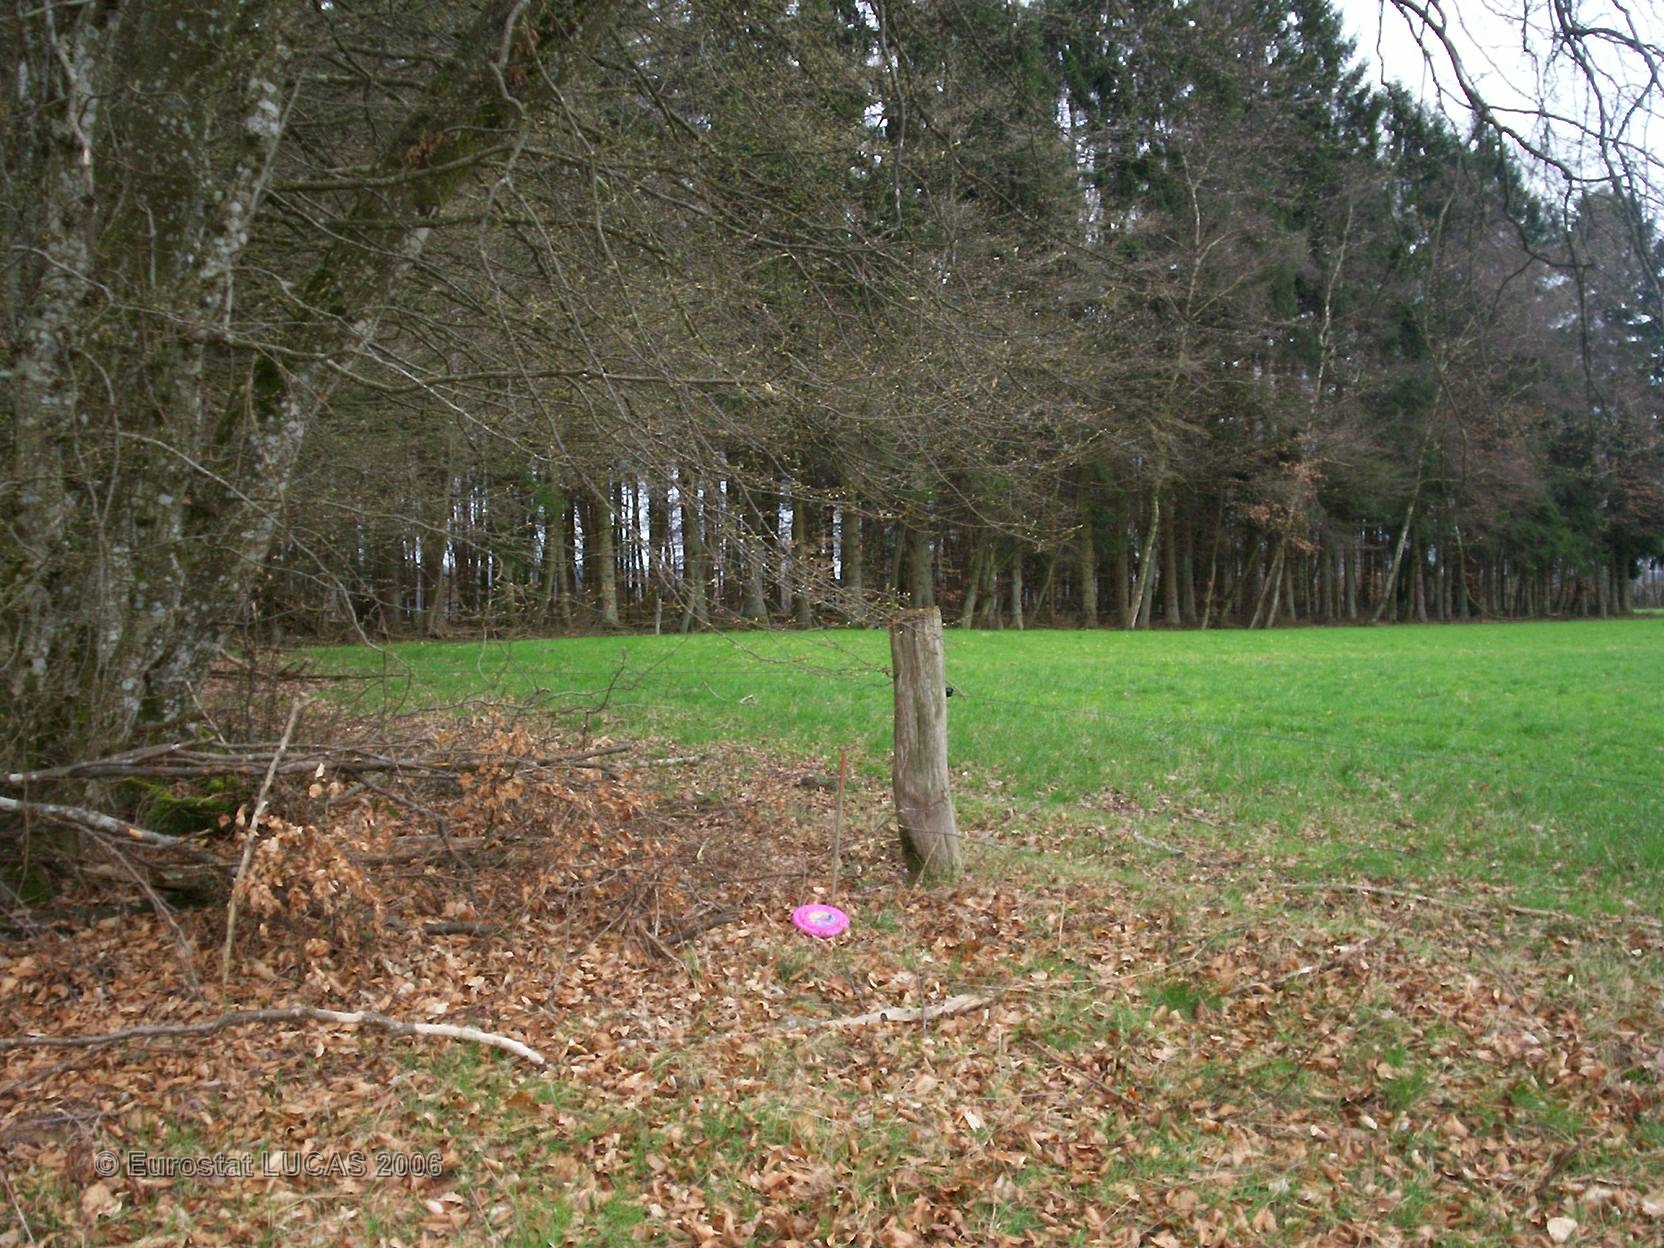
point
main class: Woodland
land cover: Broadleaved forest
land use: Forestry
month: April
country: FR
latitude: 48.0160
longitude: 6.2603
